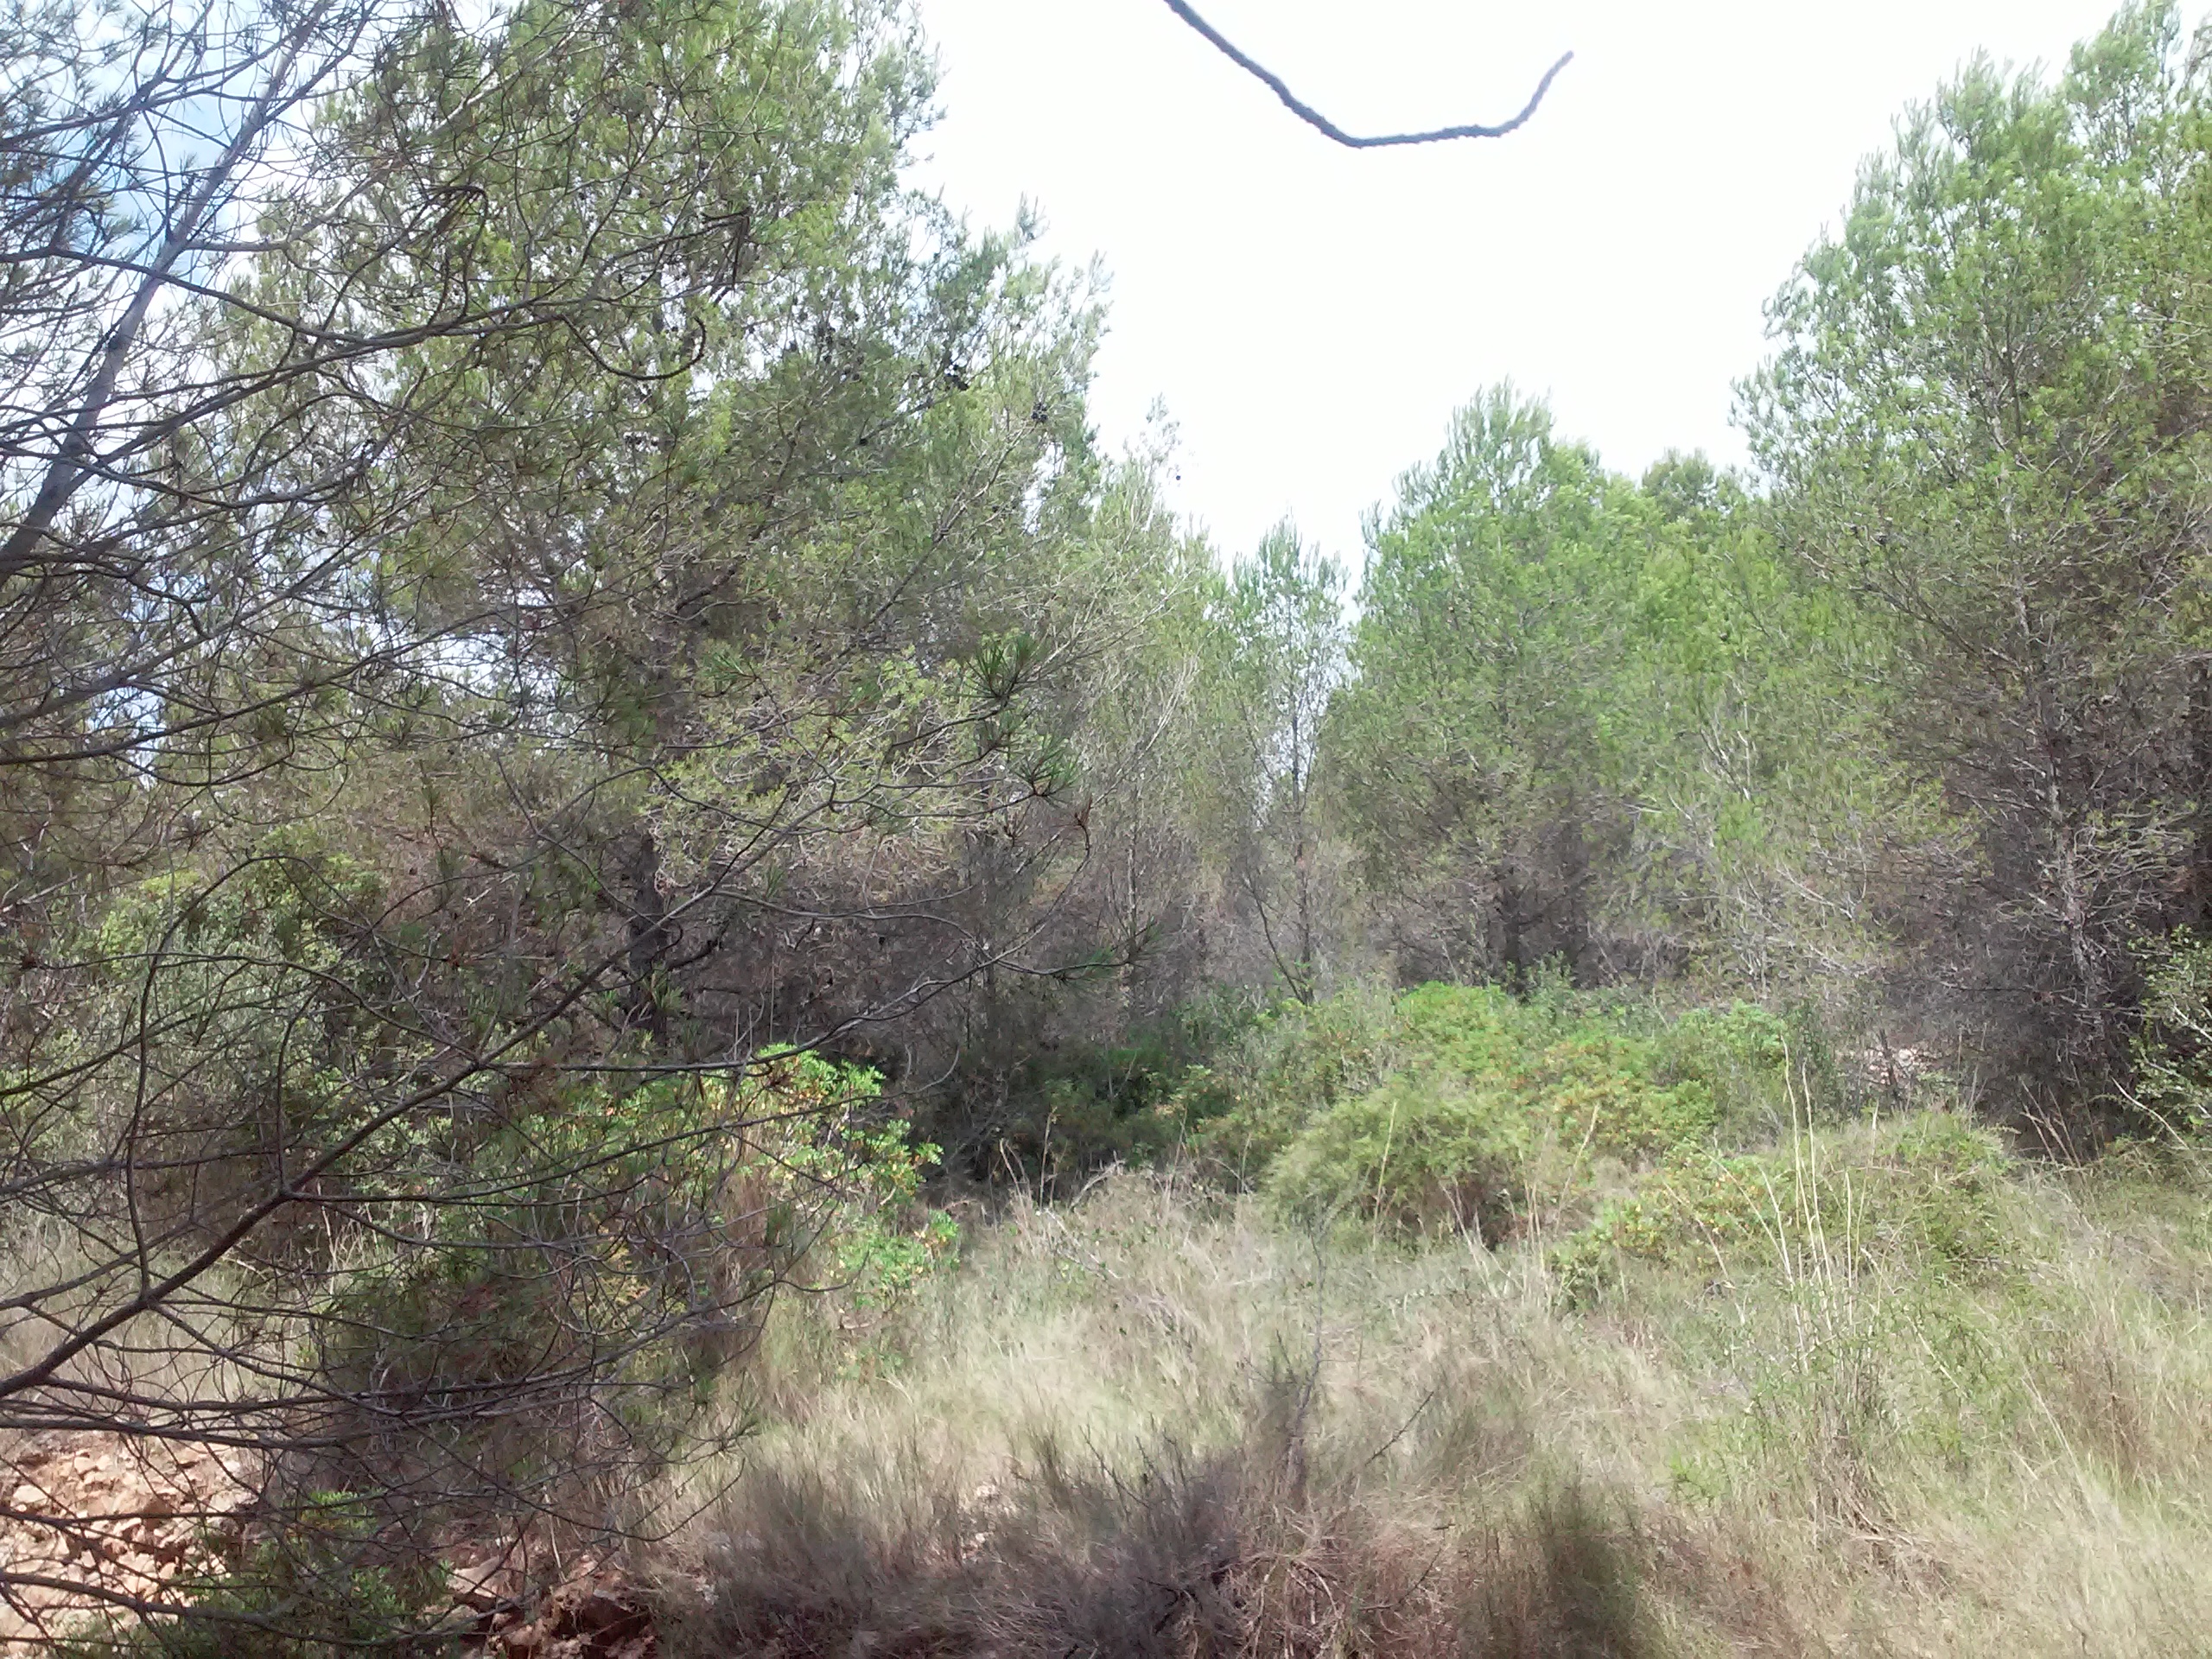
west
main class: Woodland
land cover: Pine dominated coniferous woodland
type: coniferous forest of the mediterranean region
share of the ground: 25 - 50 %
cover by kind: coniferous forest trees 35 %, shrubs 25 %, herbaceous plants 15 %, broadleaved forest trees 10 %, lichens and mosses 10 %, consolidated bare surface 5 %
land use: Semi-natural and natural areas not in use
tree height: < 5 m
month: July
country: ES
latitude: 41.1335
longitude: 1.2858
